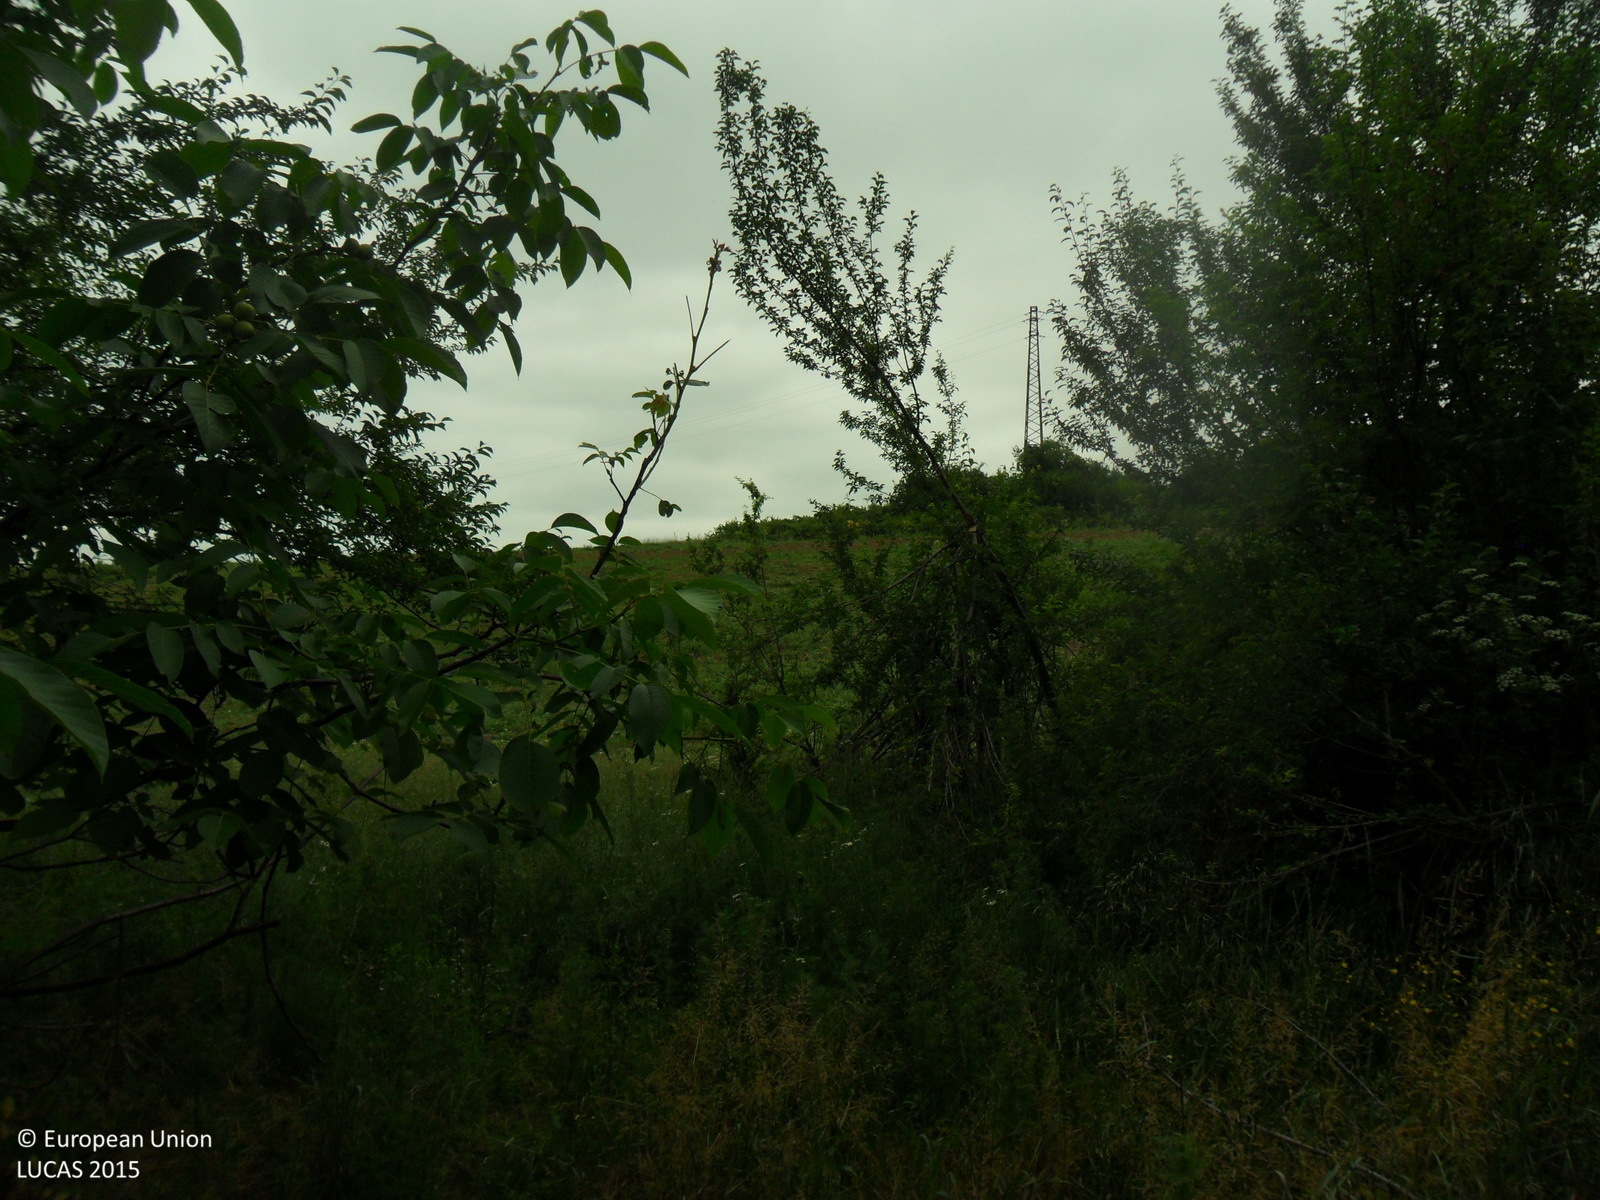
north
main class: Cropland
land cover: Other fruit trees and berries
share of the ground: > 75 %
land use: Agriculture (excluding fallow land and kitchen gardens)
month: June
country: BG
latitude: 43.7078
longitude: 26.7809
